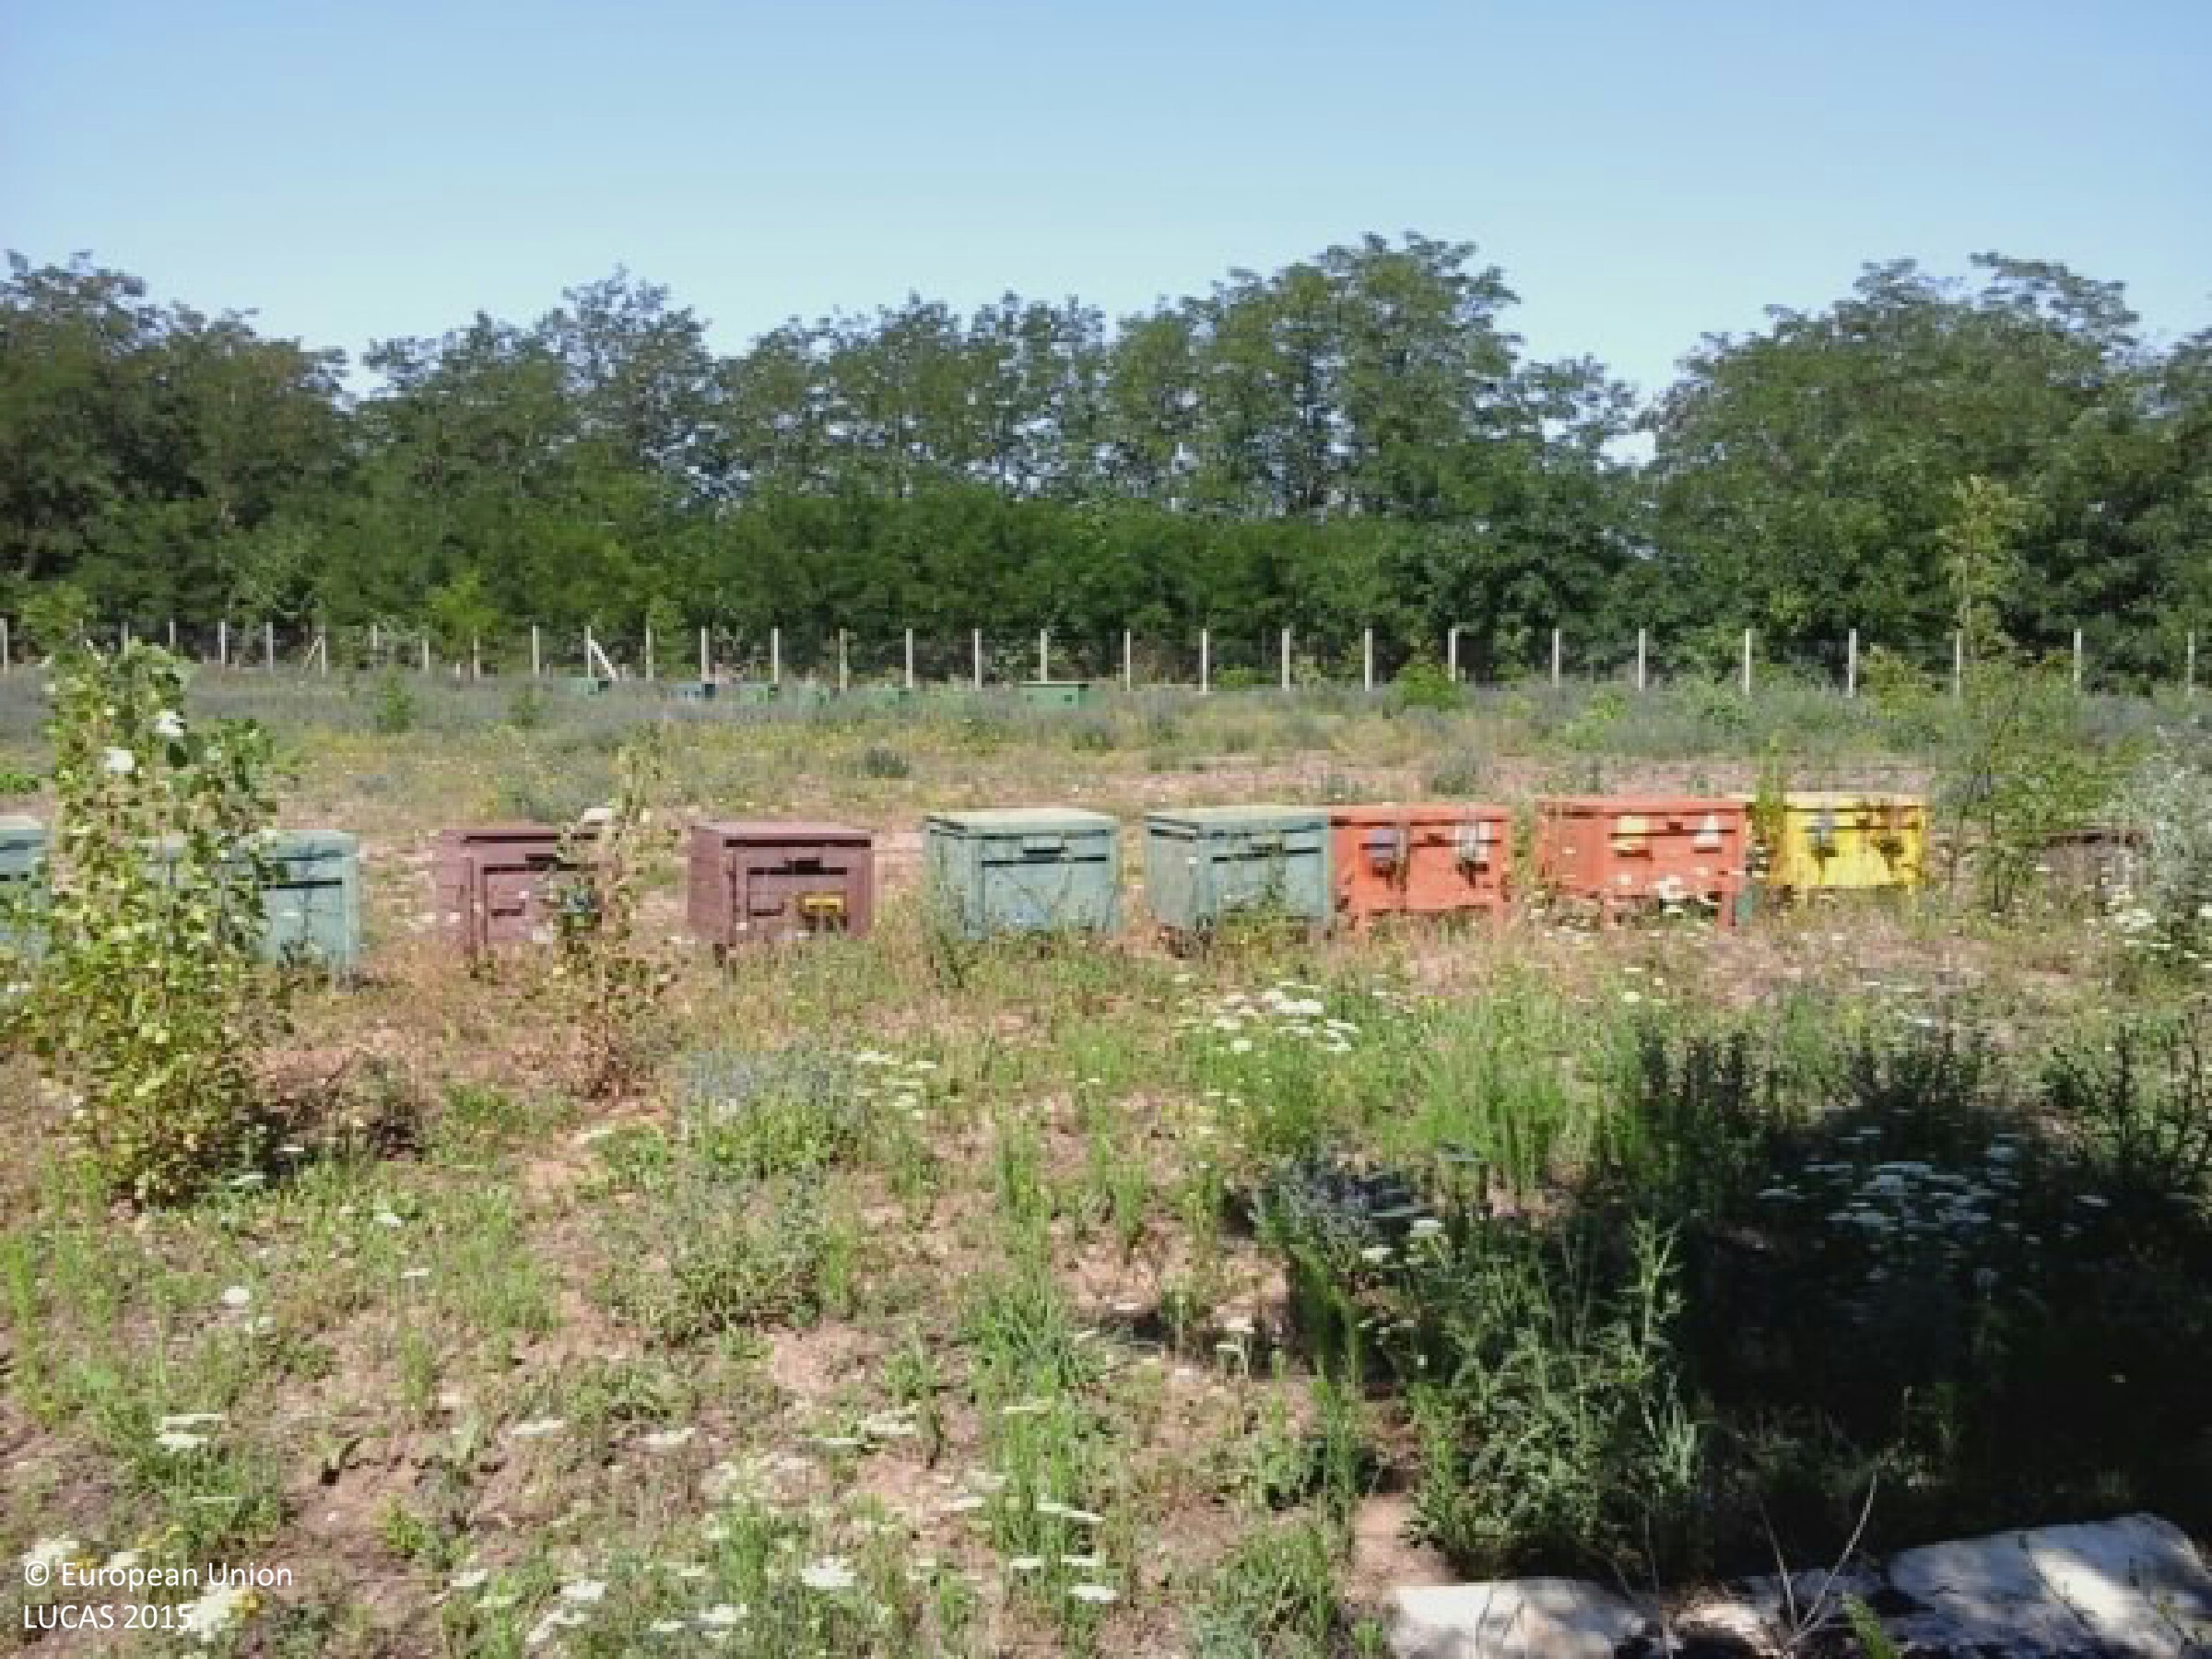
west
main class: Grassland
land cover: Spontaneously vegetated surfaces
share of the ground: > 75 %
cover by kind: herbaceous plants 100 %
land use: Agriculture (excluding fallow land and kitchen gardens)
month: July
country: HU
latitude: 48.2620
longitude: 20.7189
